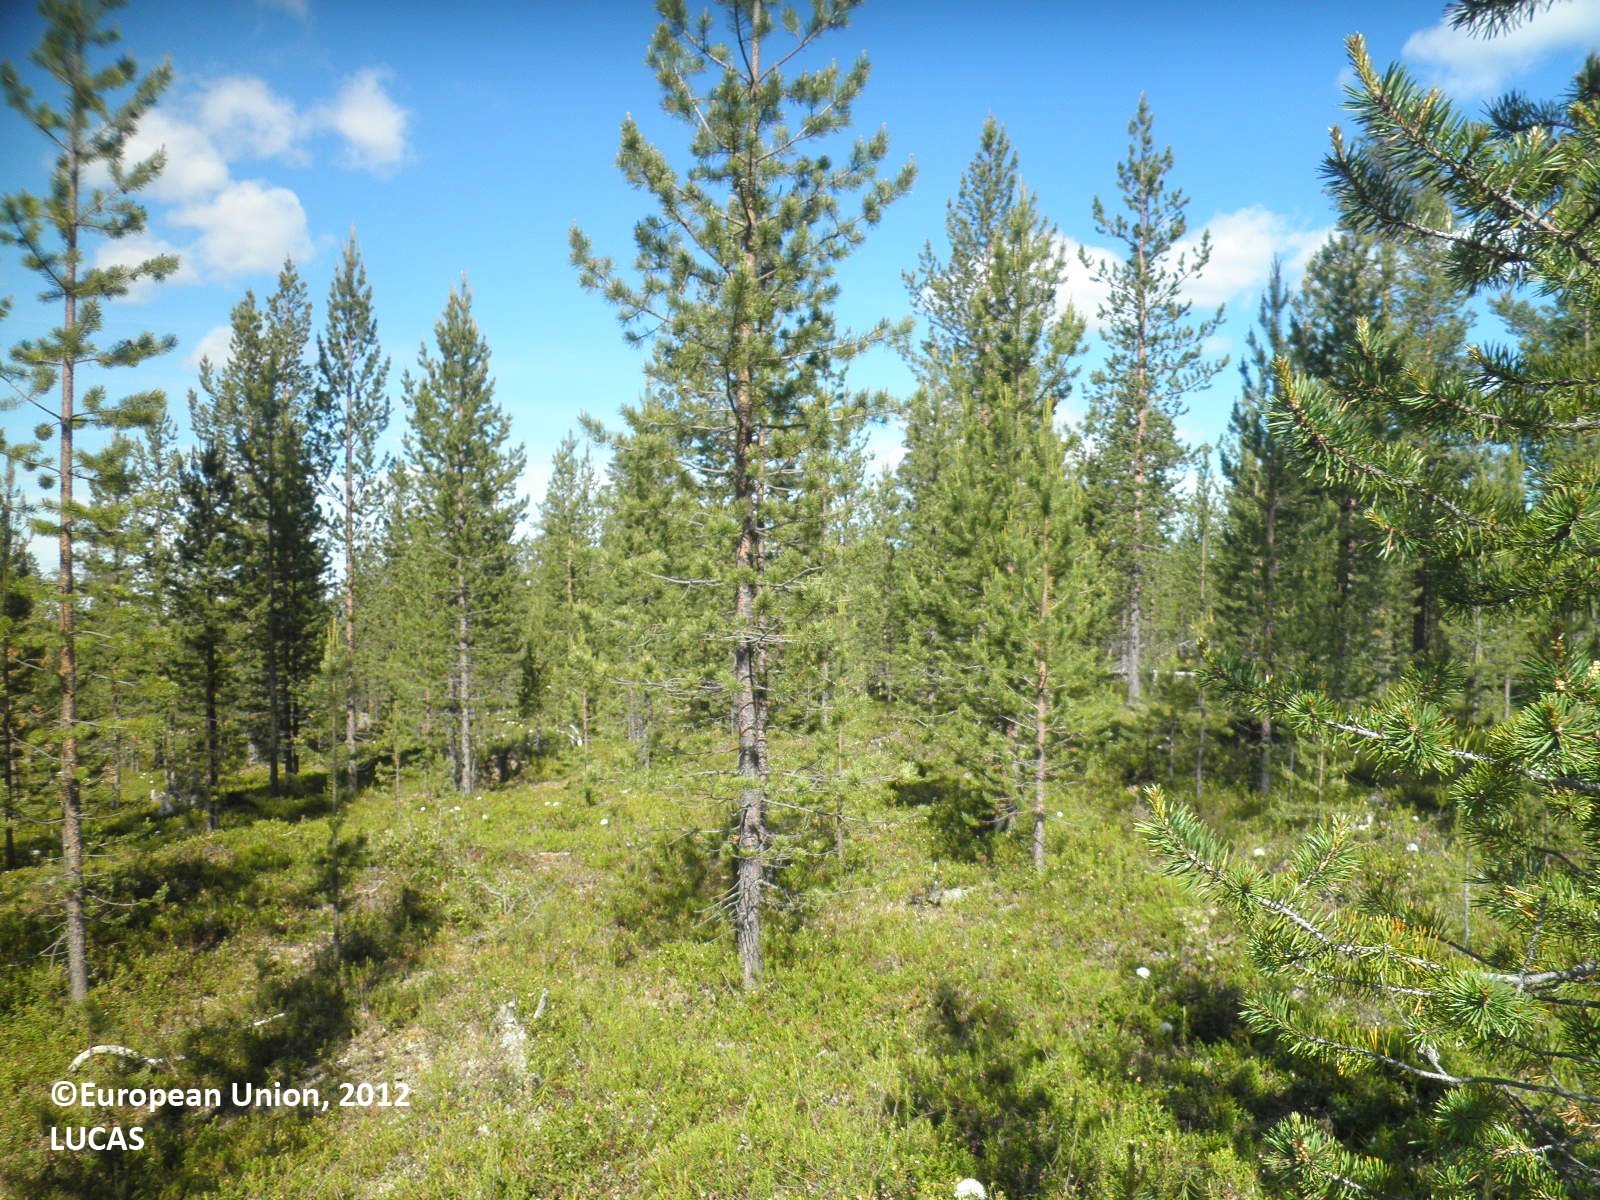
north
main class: Woodland
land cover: Pine dominated coniferous woodland
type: boreal forest
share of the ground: 25 - 50 %
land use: Forestry
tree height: > 5 m
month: July
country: FI
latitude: 68.7972
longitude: 26.8302
